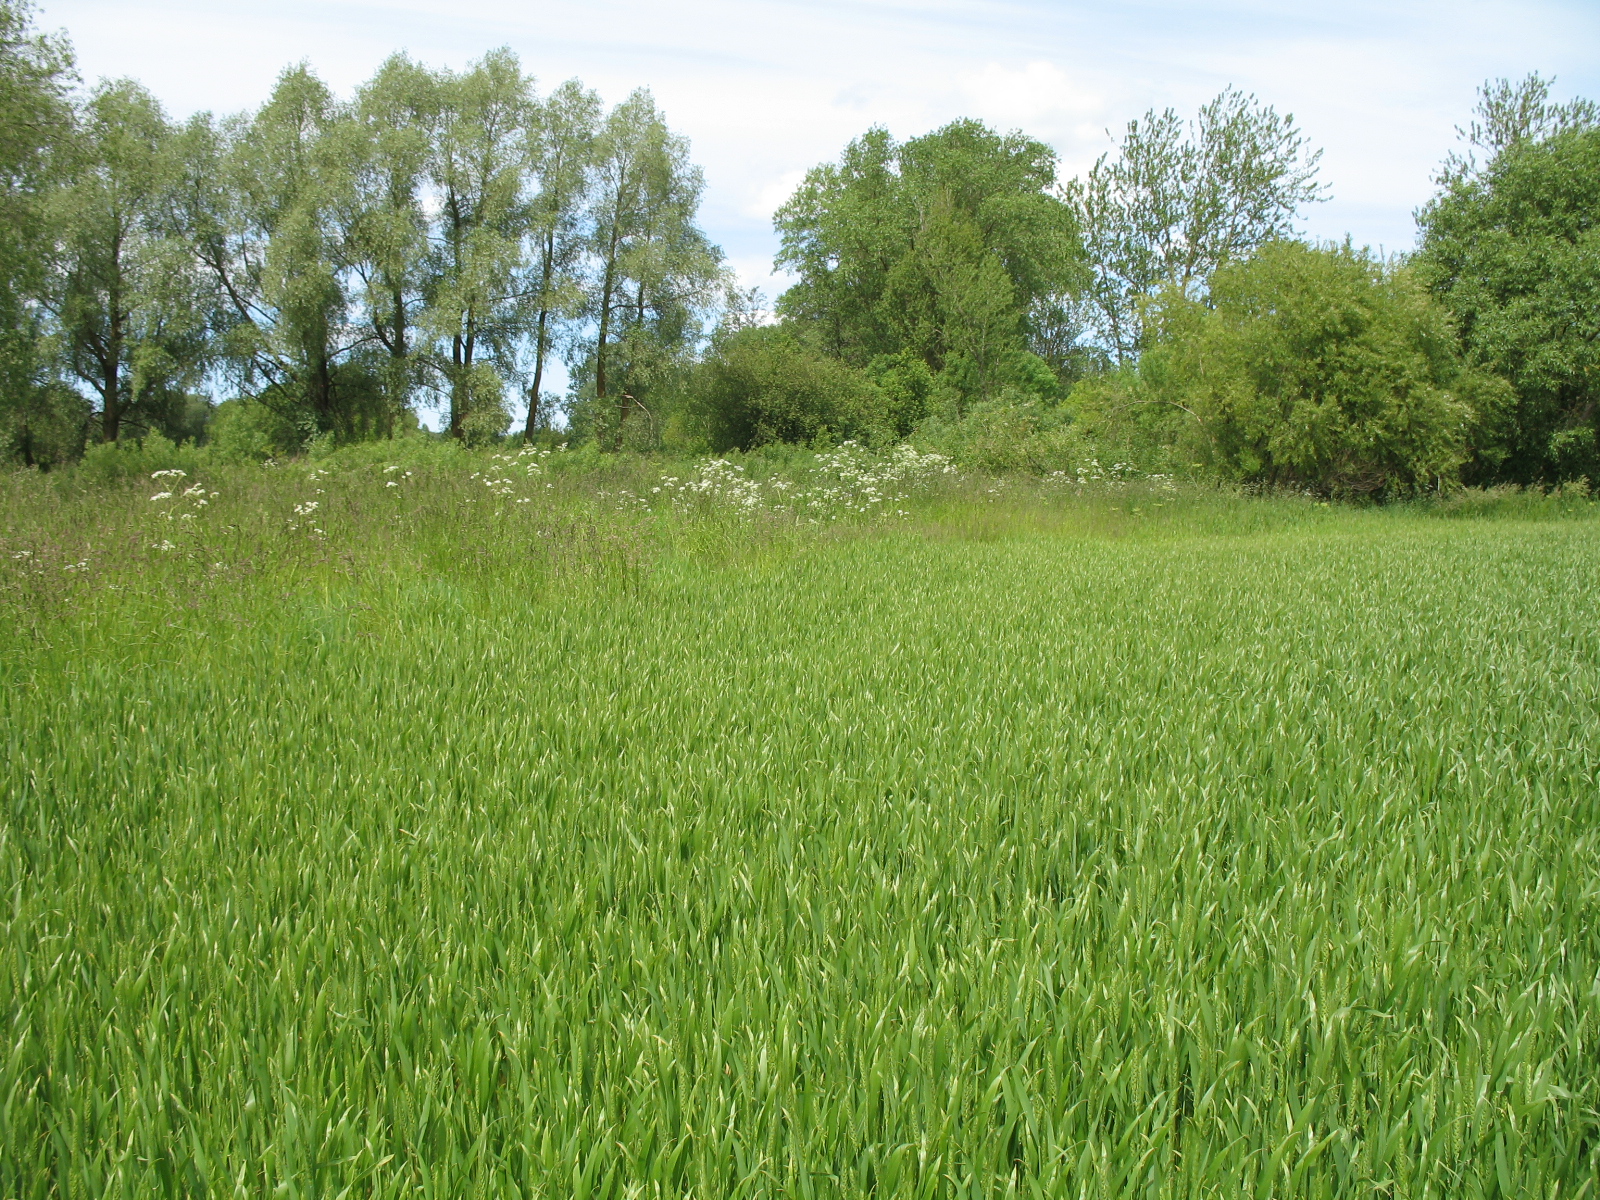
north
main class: Cropland
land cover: Barley
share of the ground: > 75 %
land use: Agriculture (excluding fallow land and kitchen gardens)
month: June
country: LV
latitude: 56.6076
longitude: 23.4489
